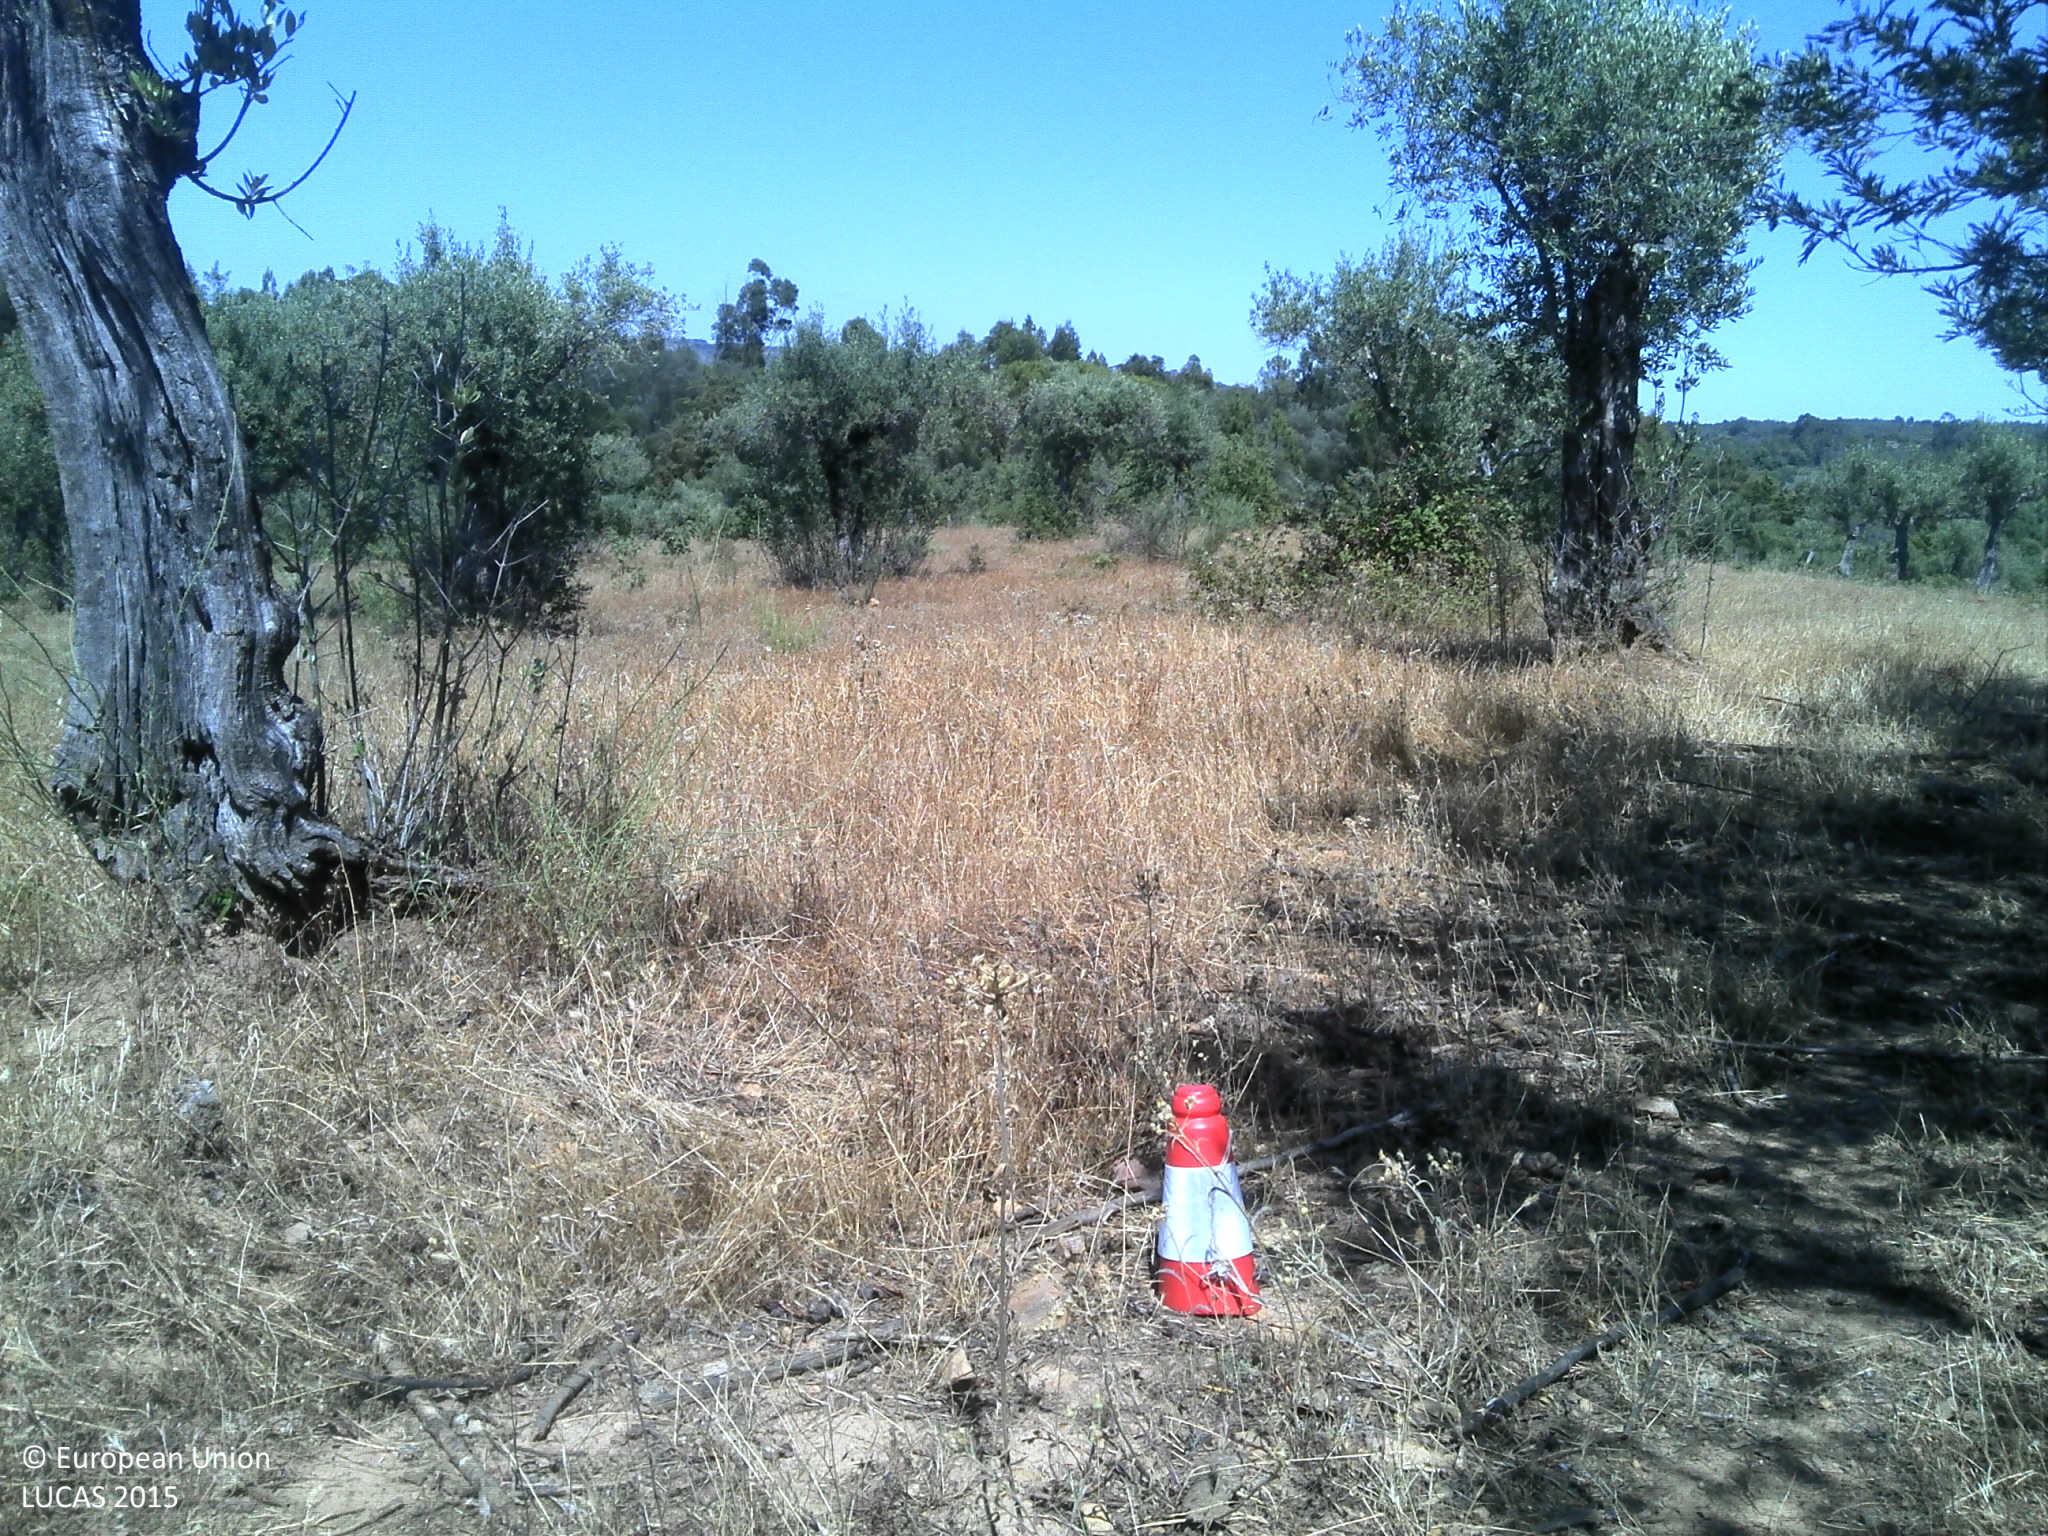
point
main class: Cropland
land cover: Olive groves
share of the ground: 25 - 50 %
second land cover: Grassland without tree/shrub cover
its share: 25 - 50 %
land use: Agriculture (excluding fallow land and kitchen gardens)
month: June
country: PT
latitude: 40.0768
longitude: -7.2294
